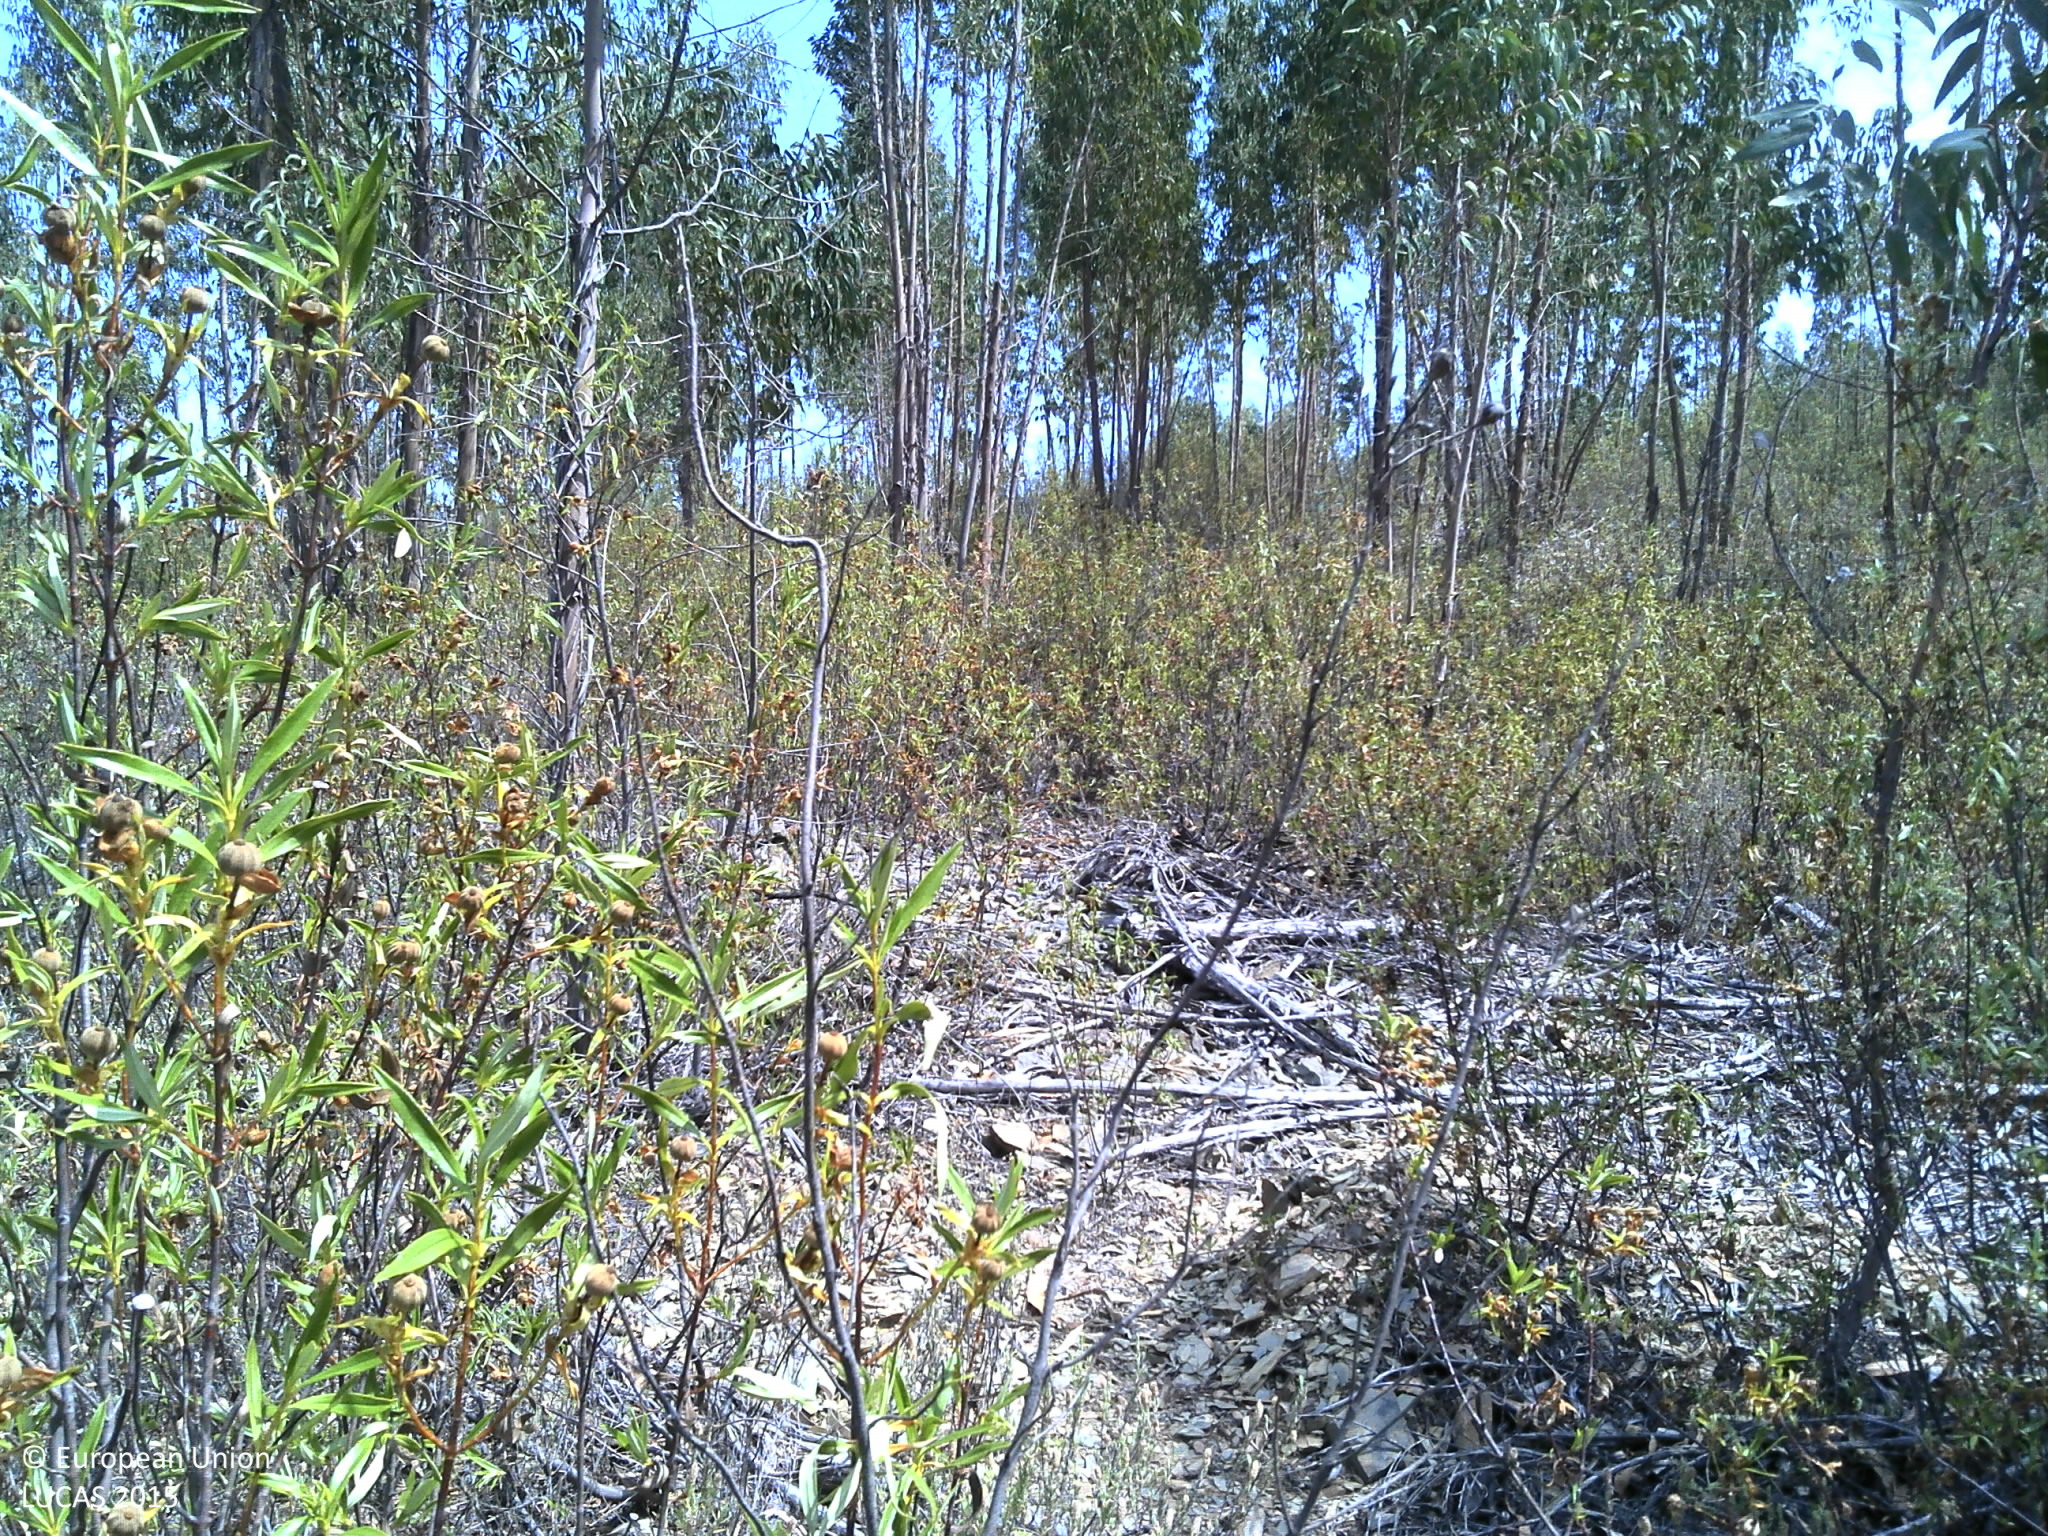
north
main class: Woodland
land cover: Broadleaved woodland
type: exotic forest
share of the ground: 10 - 25 %
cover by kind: shrubs 60 %, broadleaved forest trees 20 %, unconsolidated bare surface 20 %
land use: Forestry
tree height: > 5 m
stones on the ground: > 50 %
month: July
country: PT
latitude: 39.5446
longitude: -7.9198
